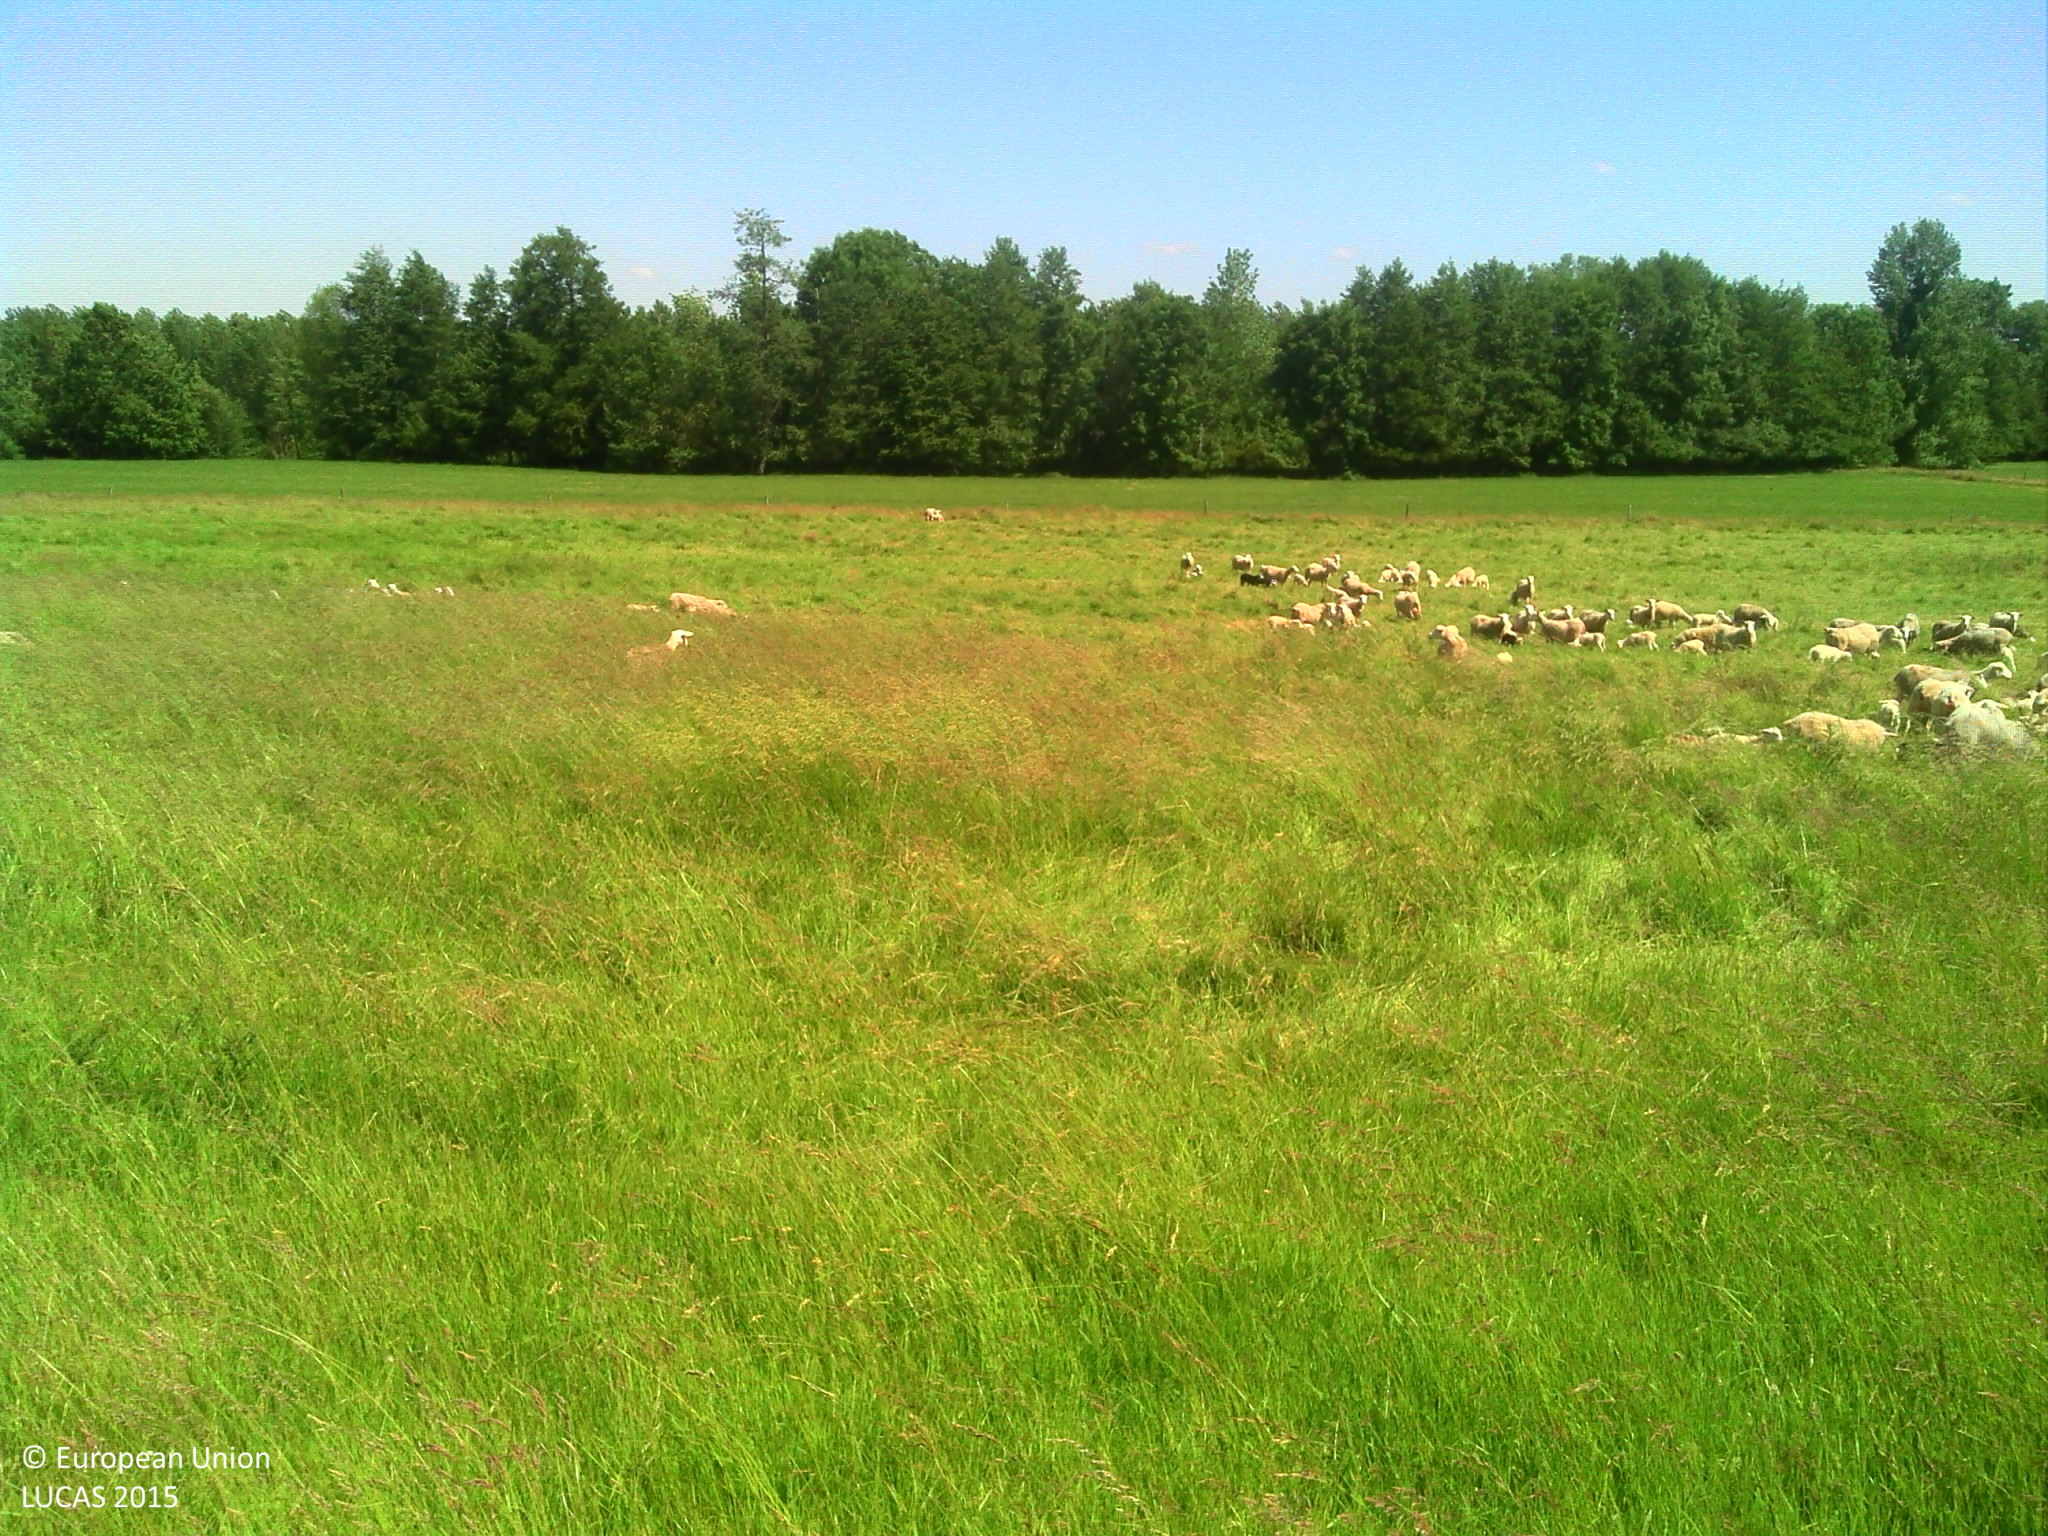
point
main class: Grassland
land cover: Grassland without tree/shrub cover
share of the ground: > 75 %
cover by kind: herbaceous plants 100 %
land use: Agriculture (excluding fallow land and kitchen gardens)
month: June
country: FR
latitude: 49.6697
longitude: 4.0783
